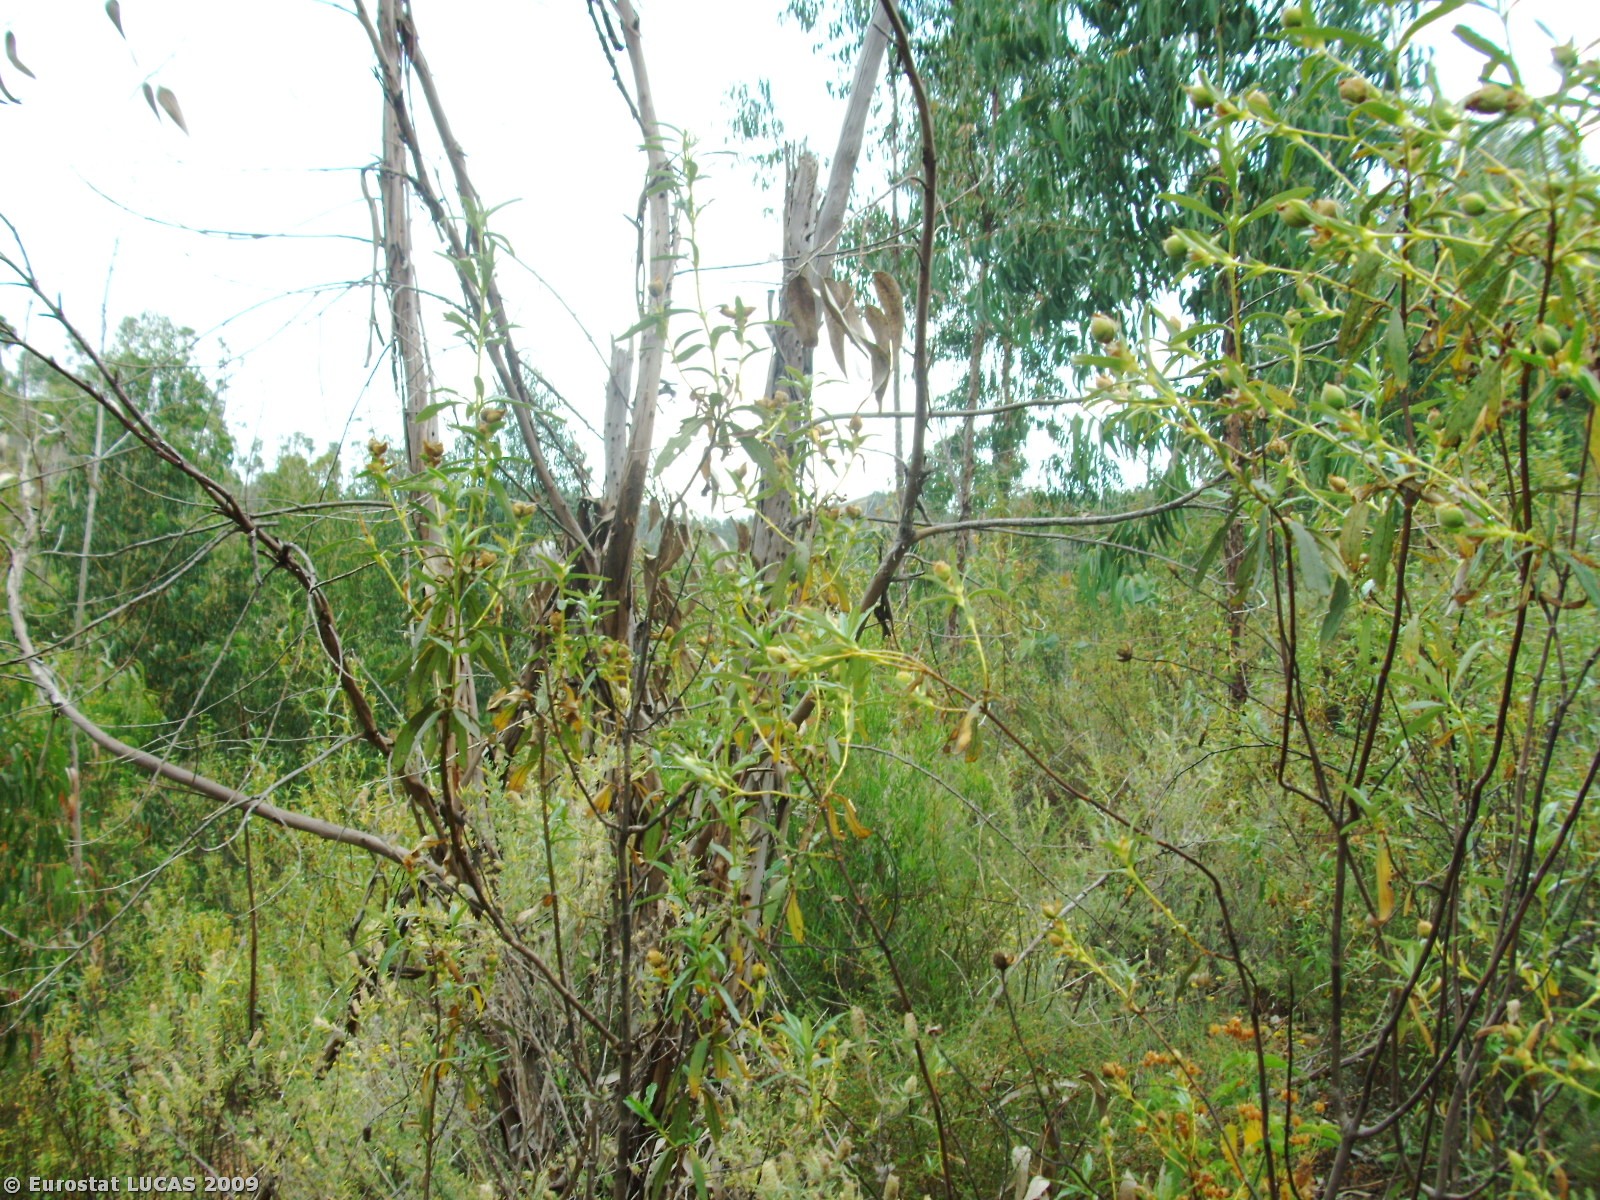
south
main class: Woodland
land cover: Broadleaved woodland
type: plantations and self-sown exotic forest
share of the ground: 25 - 50 %
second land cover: Shrubland with sparse tree cover
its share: 25 - 50 %
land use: Forestry
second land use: Unused
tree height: > 5 m
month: June
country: PT
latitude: 37.2400
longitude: -8.4563
